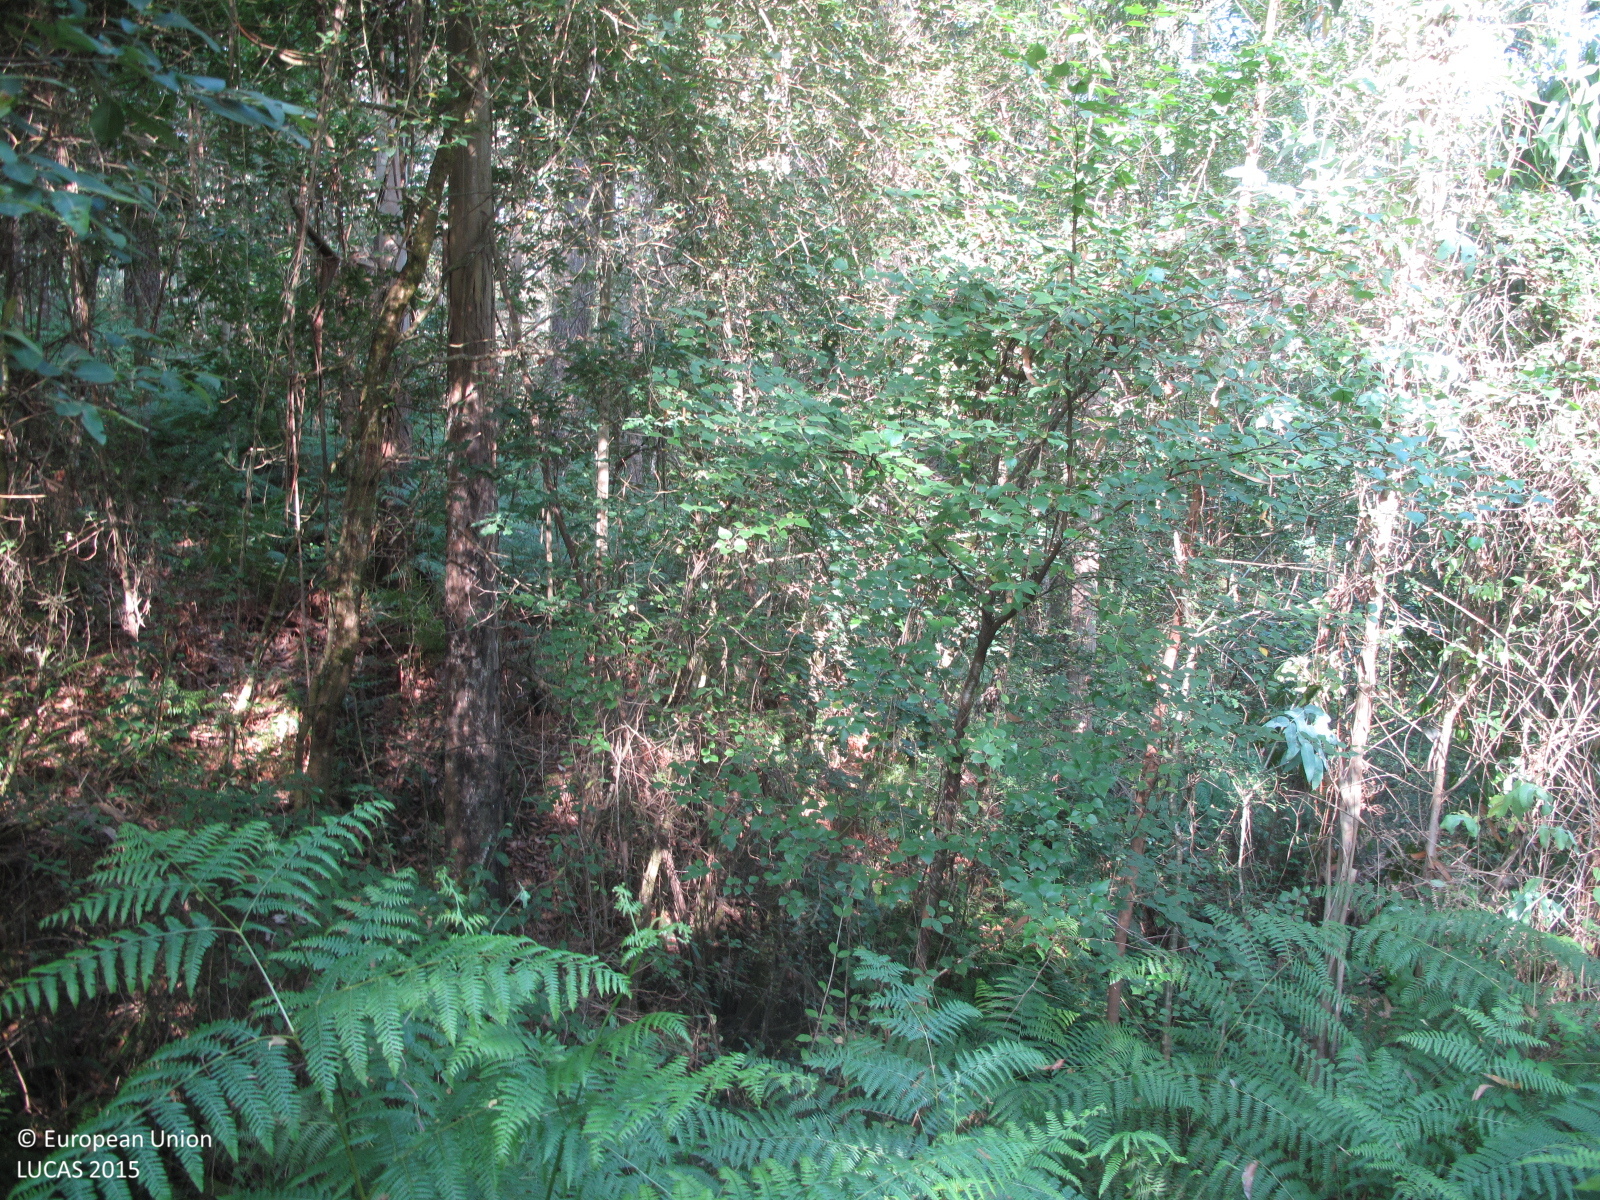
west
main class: Woodland
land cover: Broadleaved woodland
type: exotic forest
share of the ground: 50 - 75 %
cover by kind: broadleaved forest trees 60 %, shrubs 20 %, herbaceous plants 20 %
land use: Forestry
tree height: > 5 m
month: July
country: ES
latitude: 43.2864
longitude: -8.1529
